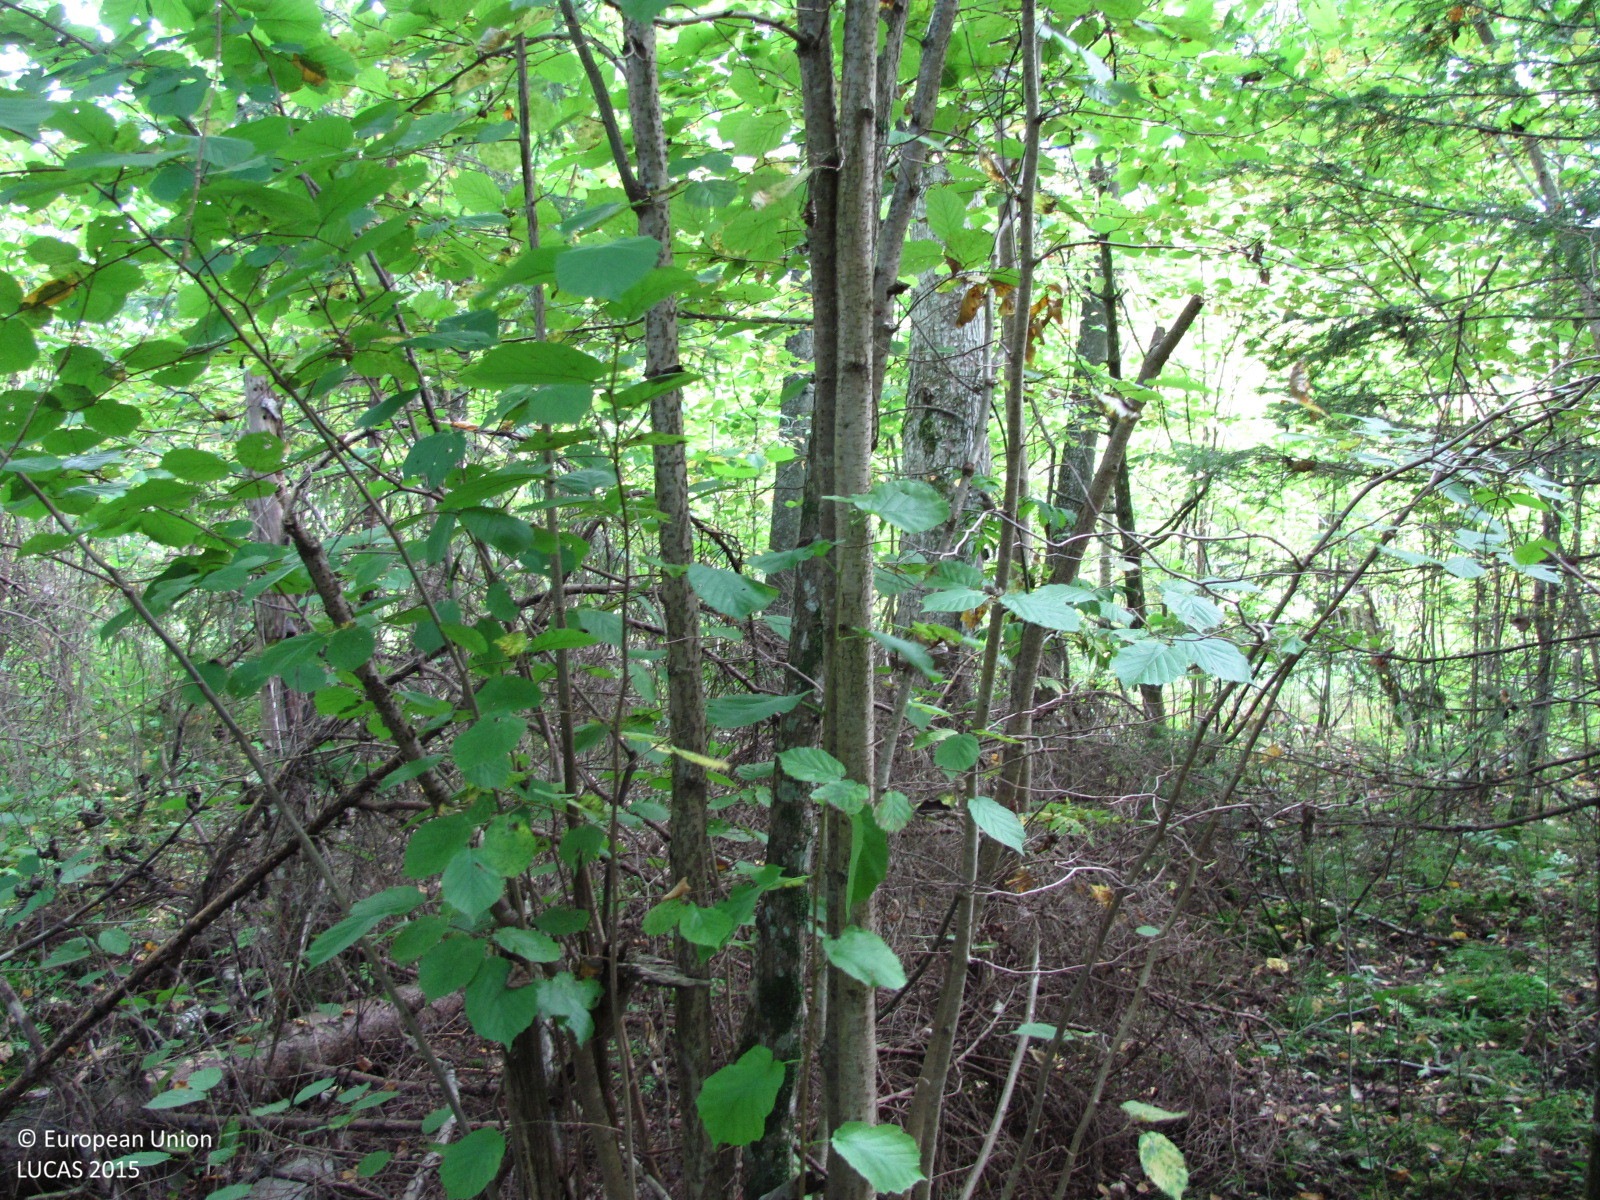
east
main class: Woodland
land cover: Spruce dominated mixed woodland
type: hemiboreal forest and nemoral coniferous forest and mixed broadleaved-coniferous forest
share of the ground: > 75 %
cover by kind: coniferous forest trees 40 %, broadleaved forest trees 40 %, herbaceous plants 10 %, lichens and mosses 10 %
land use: Forestry
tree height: > 5 m
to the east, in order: Spruce dominated mixed woodland; Broadleaved woodland; Spruce dominated mixed woodland; Broadleaved woodland
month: September
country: LV
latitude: 56.7278
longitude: 25.1629
